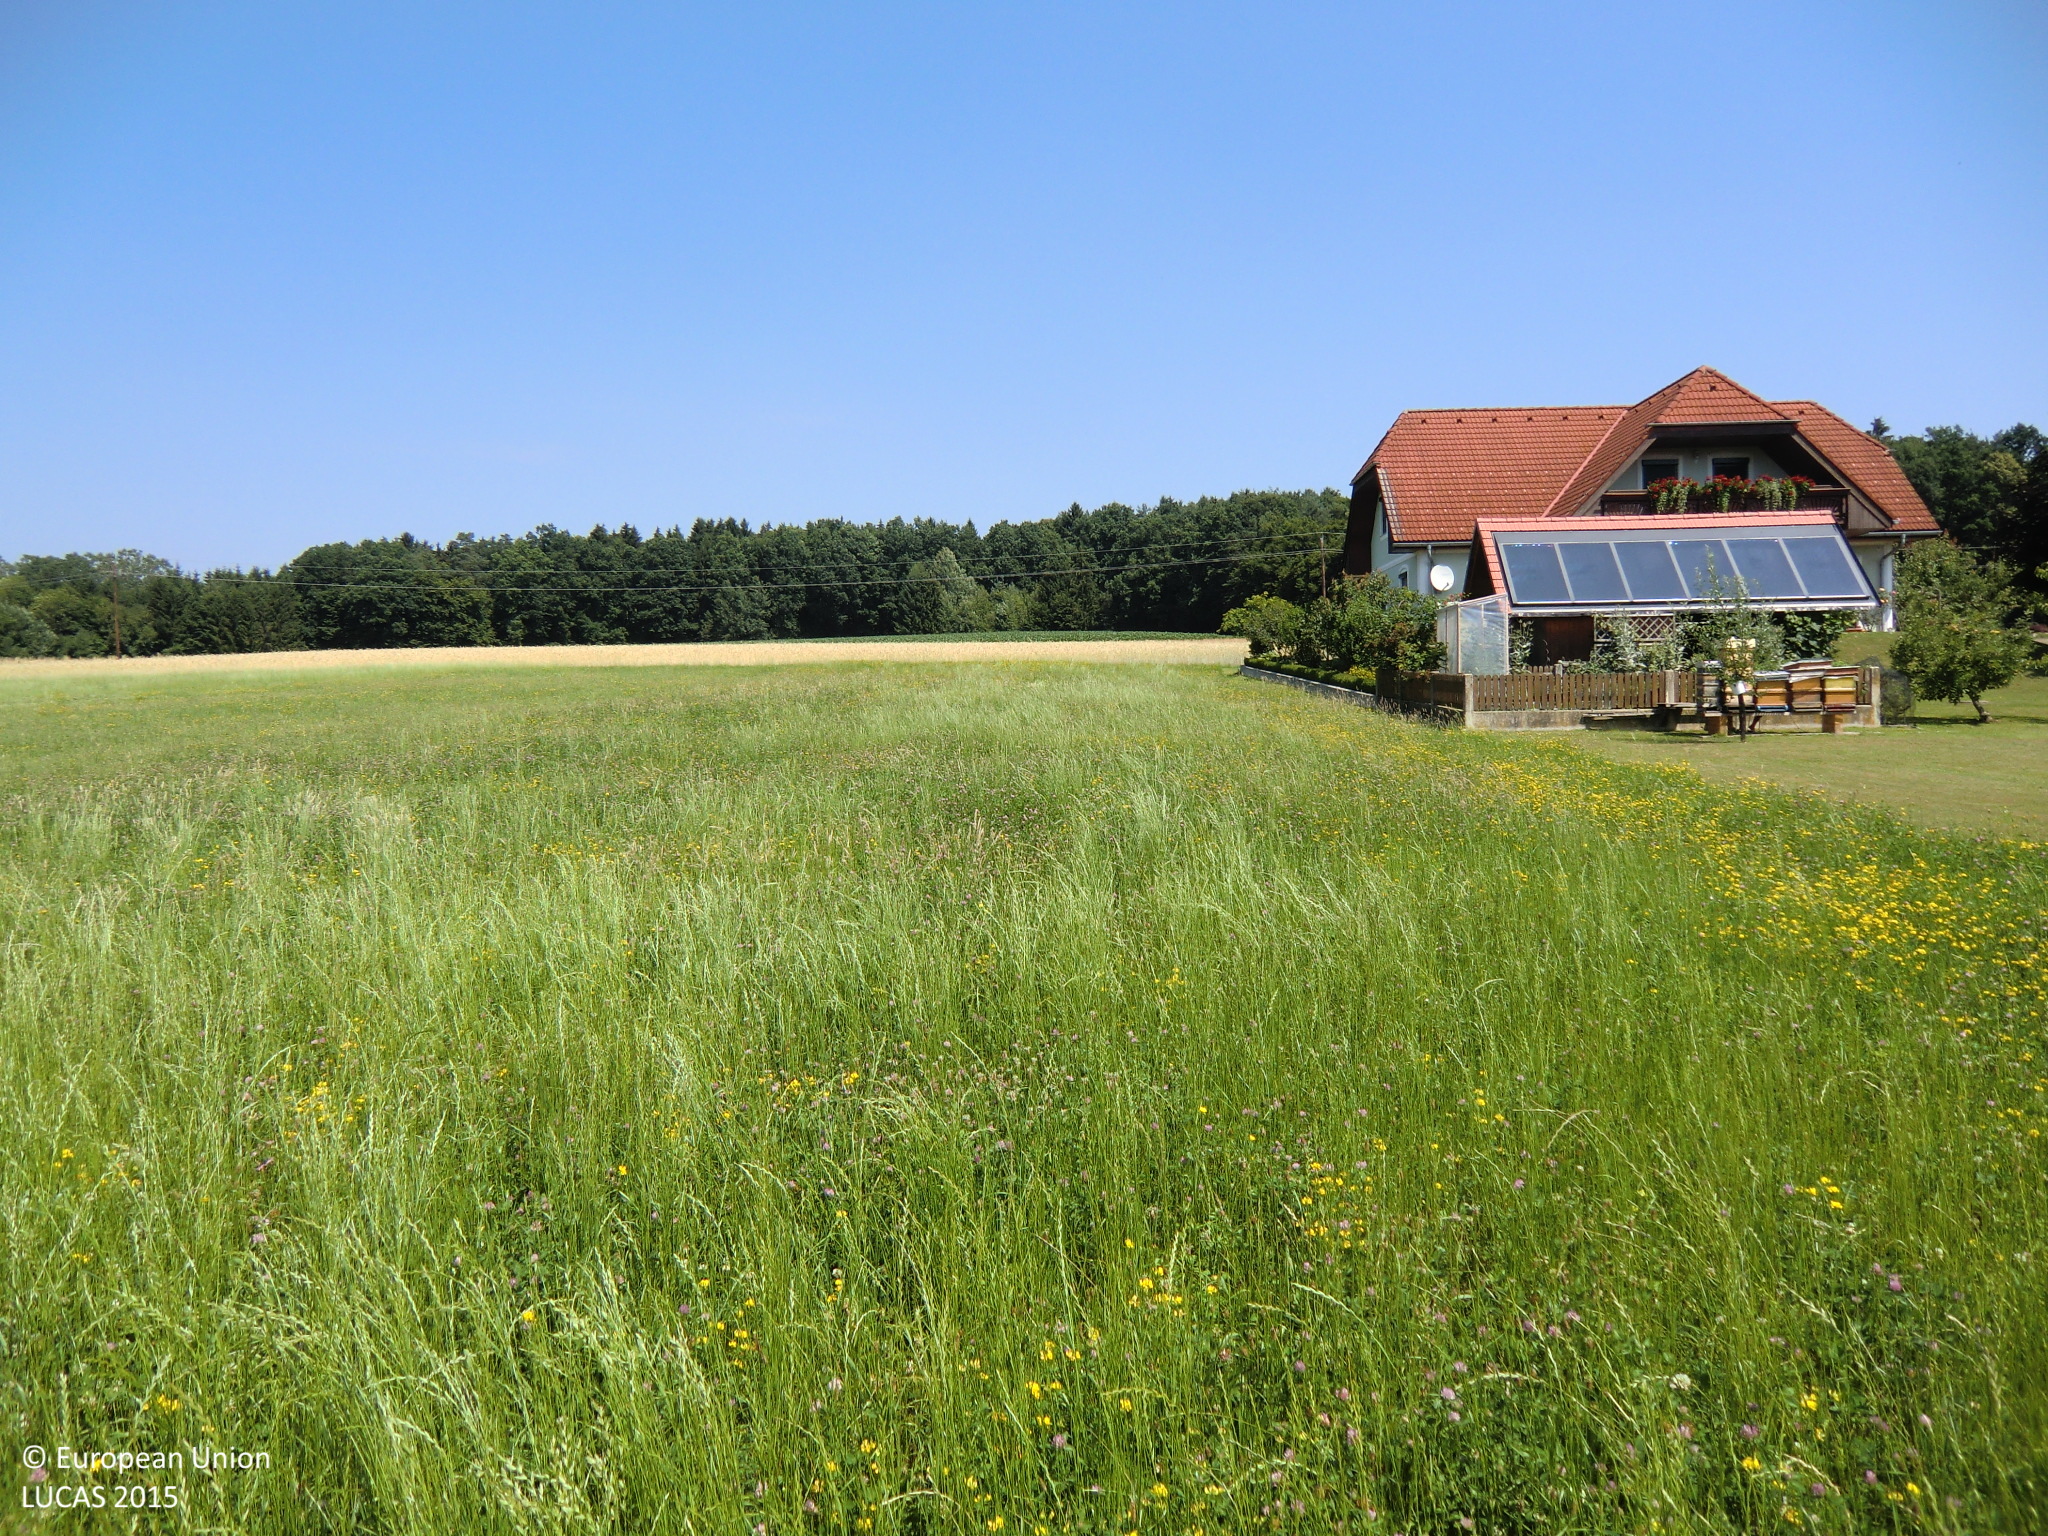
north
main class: Grassland
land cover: Grassland with sparse tree/shrub cover
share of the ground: > 75 %
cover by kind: herbaceous plants 95 %, coniferous forest trees 5 %
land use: Residential
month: July
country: AT
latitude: 47.0887
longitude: 15.9421
